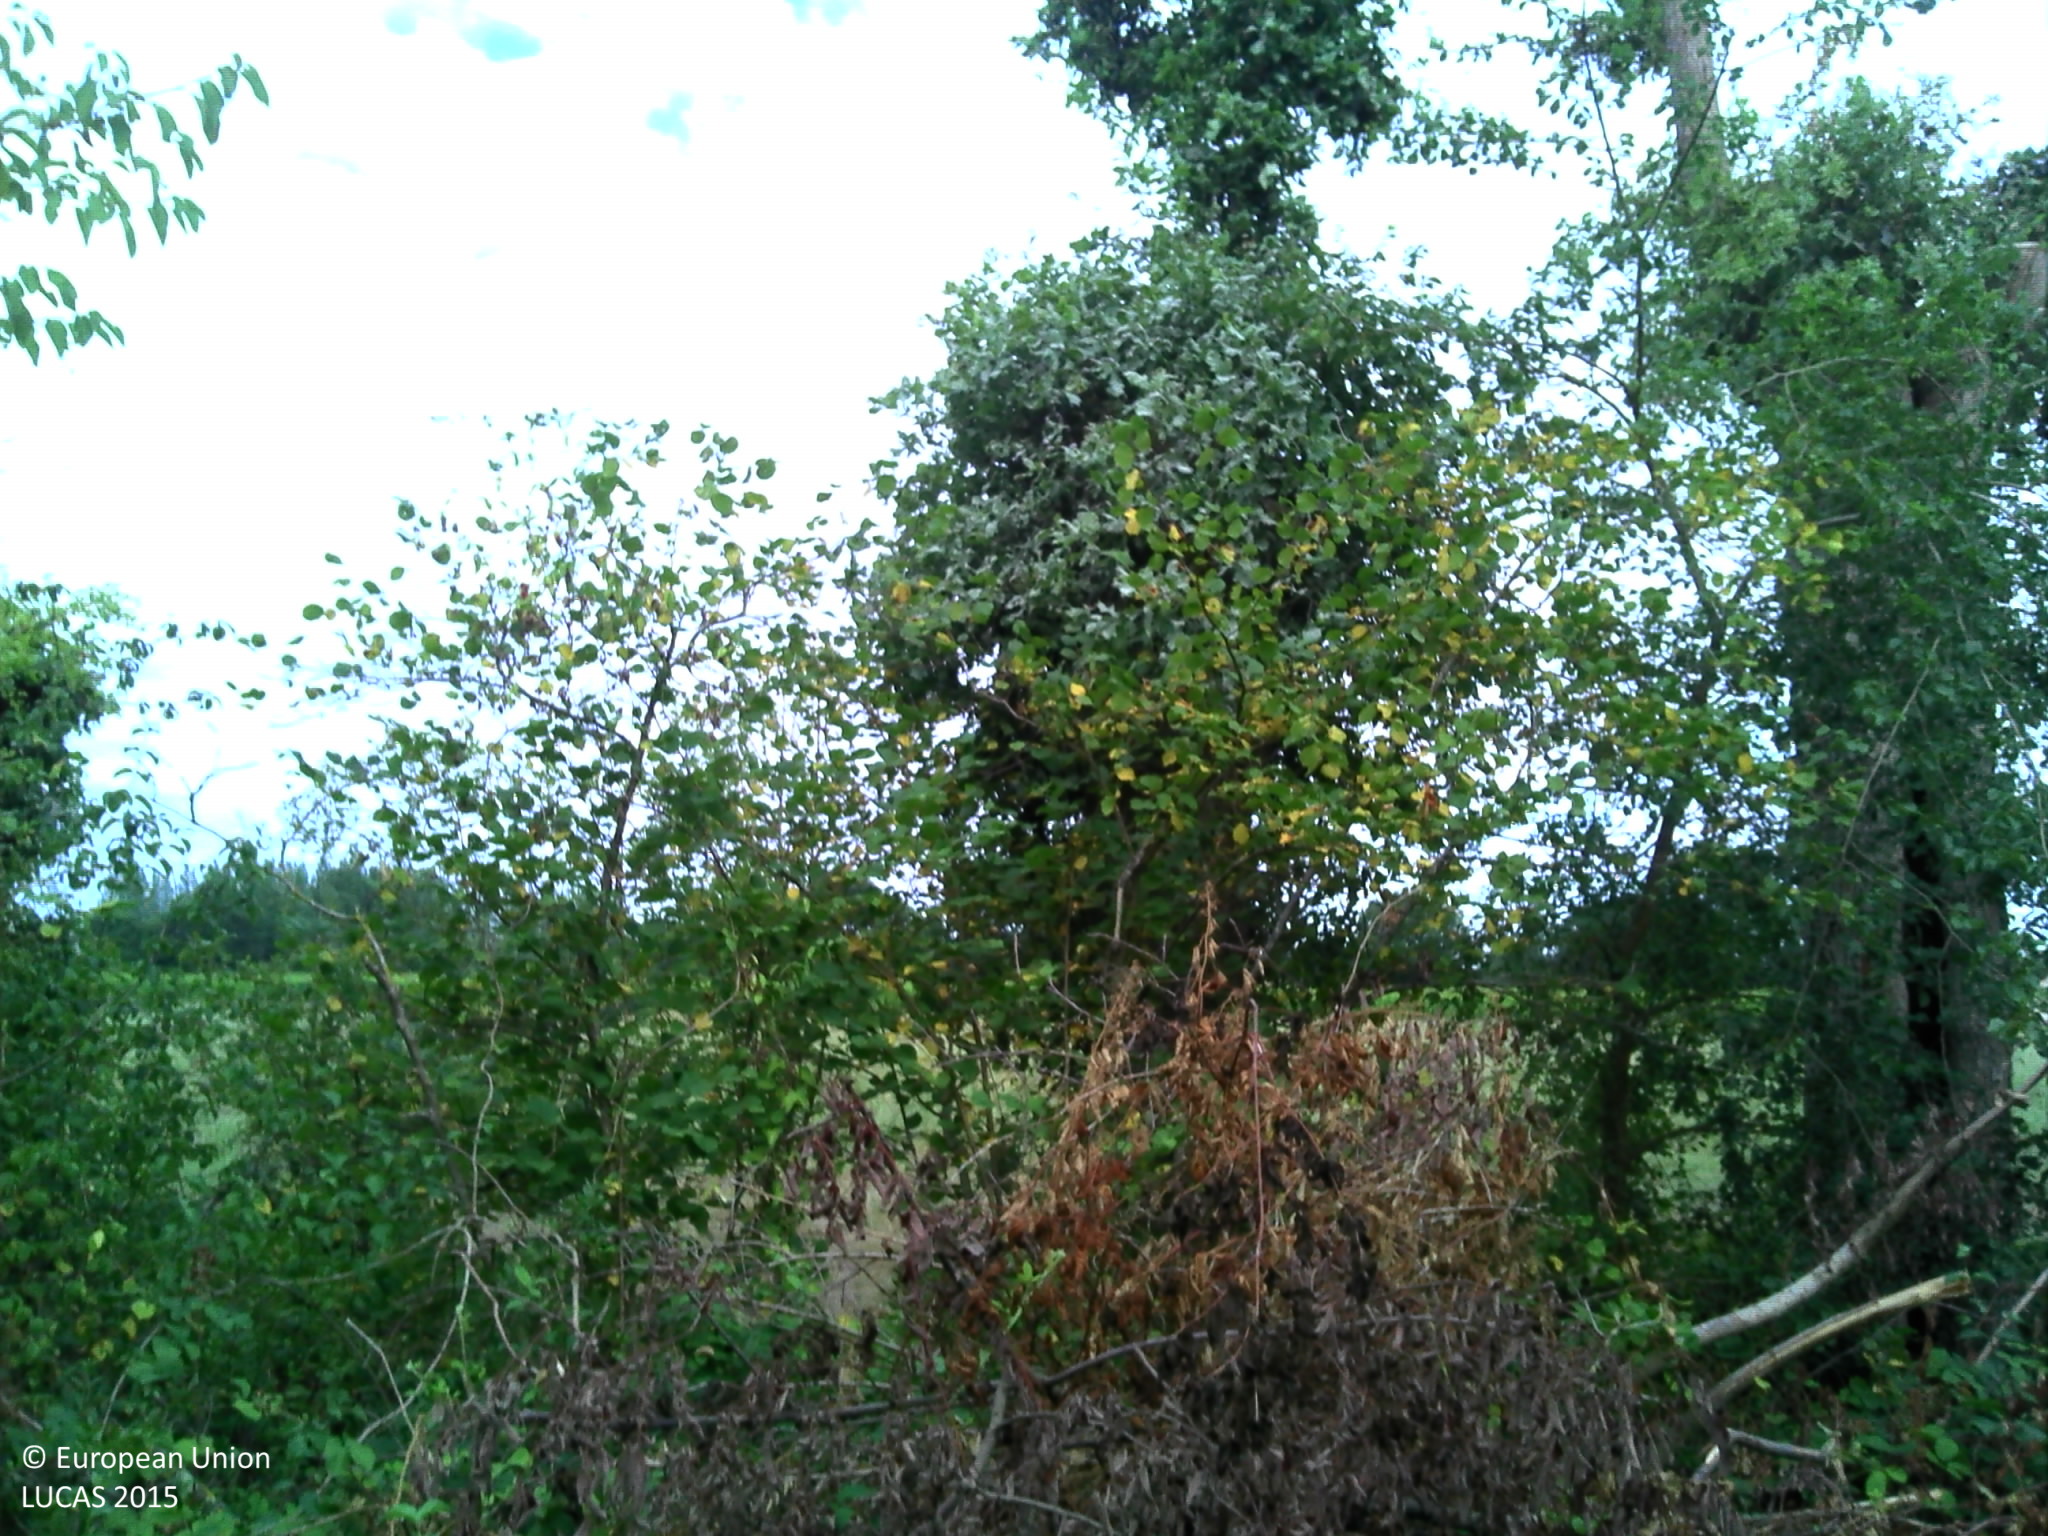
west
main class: Woodland
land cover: Pine dominated coniferous woodland
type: exotic forest
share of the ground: > 75 %
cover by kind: coniferous forest trees 75 %, broadleaved forest trees 10 %, herbaceous plants 10 %, shrubs 5 %
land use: Forestry
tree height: > 5 m
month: July
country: FR
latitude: 48.0944
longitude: 0.6188
